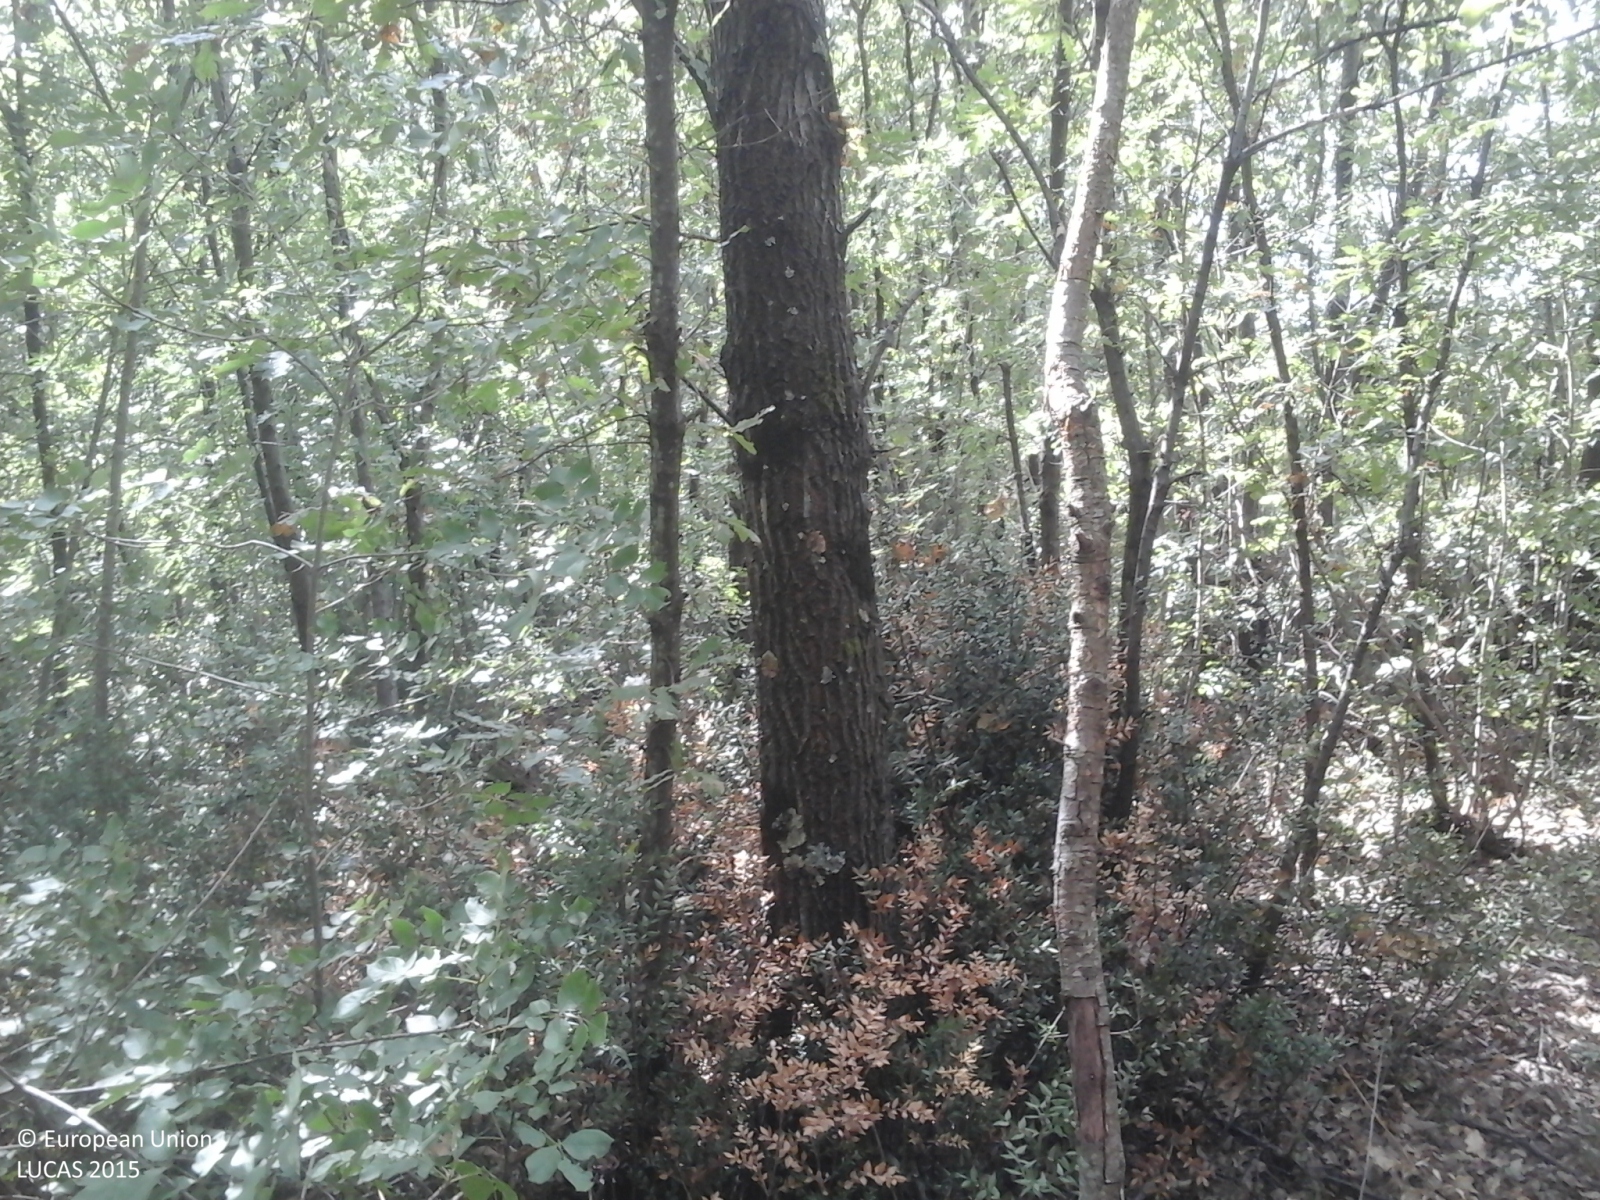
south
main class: Woodland
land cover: Broadleaved woodland
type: thermophilous deciduous forest
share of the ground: > 75 %
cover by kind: broadleaved forest trees 100 %
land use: Forestry
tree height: > 5 m
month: August
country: IT
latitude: 43.9319
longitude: 10.8822
